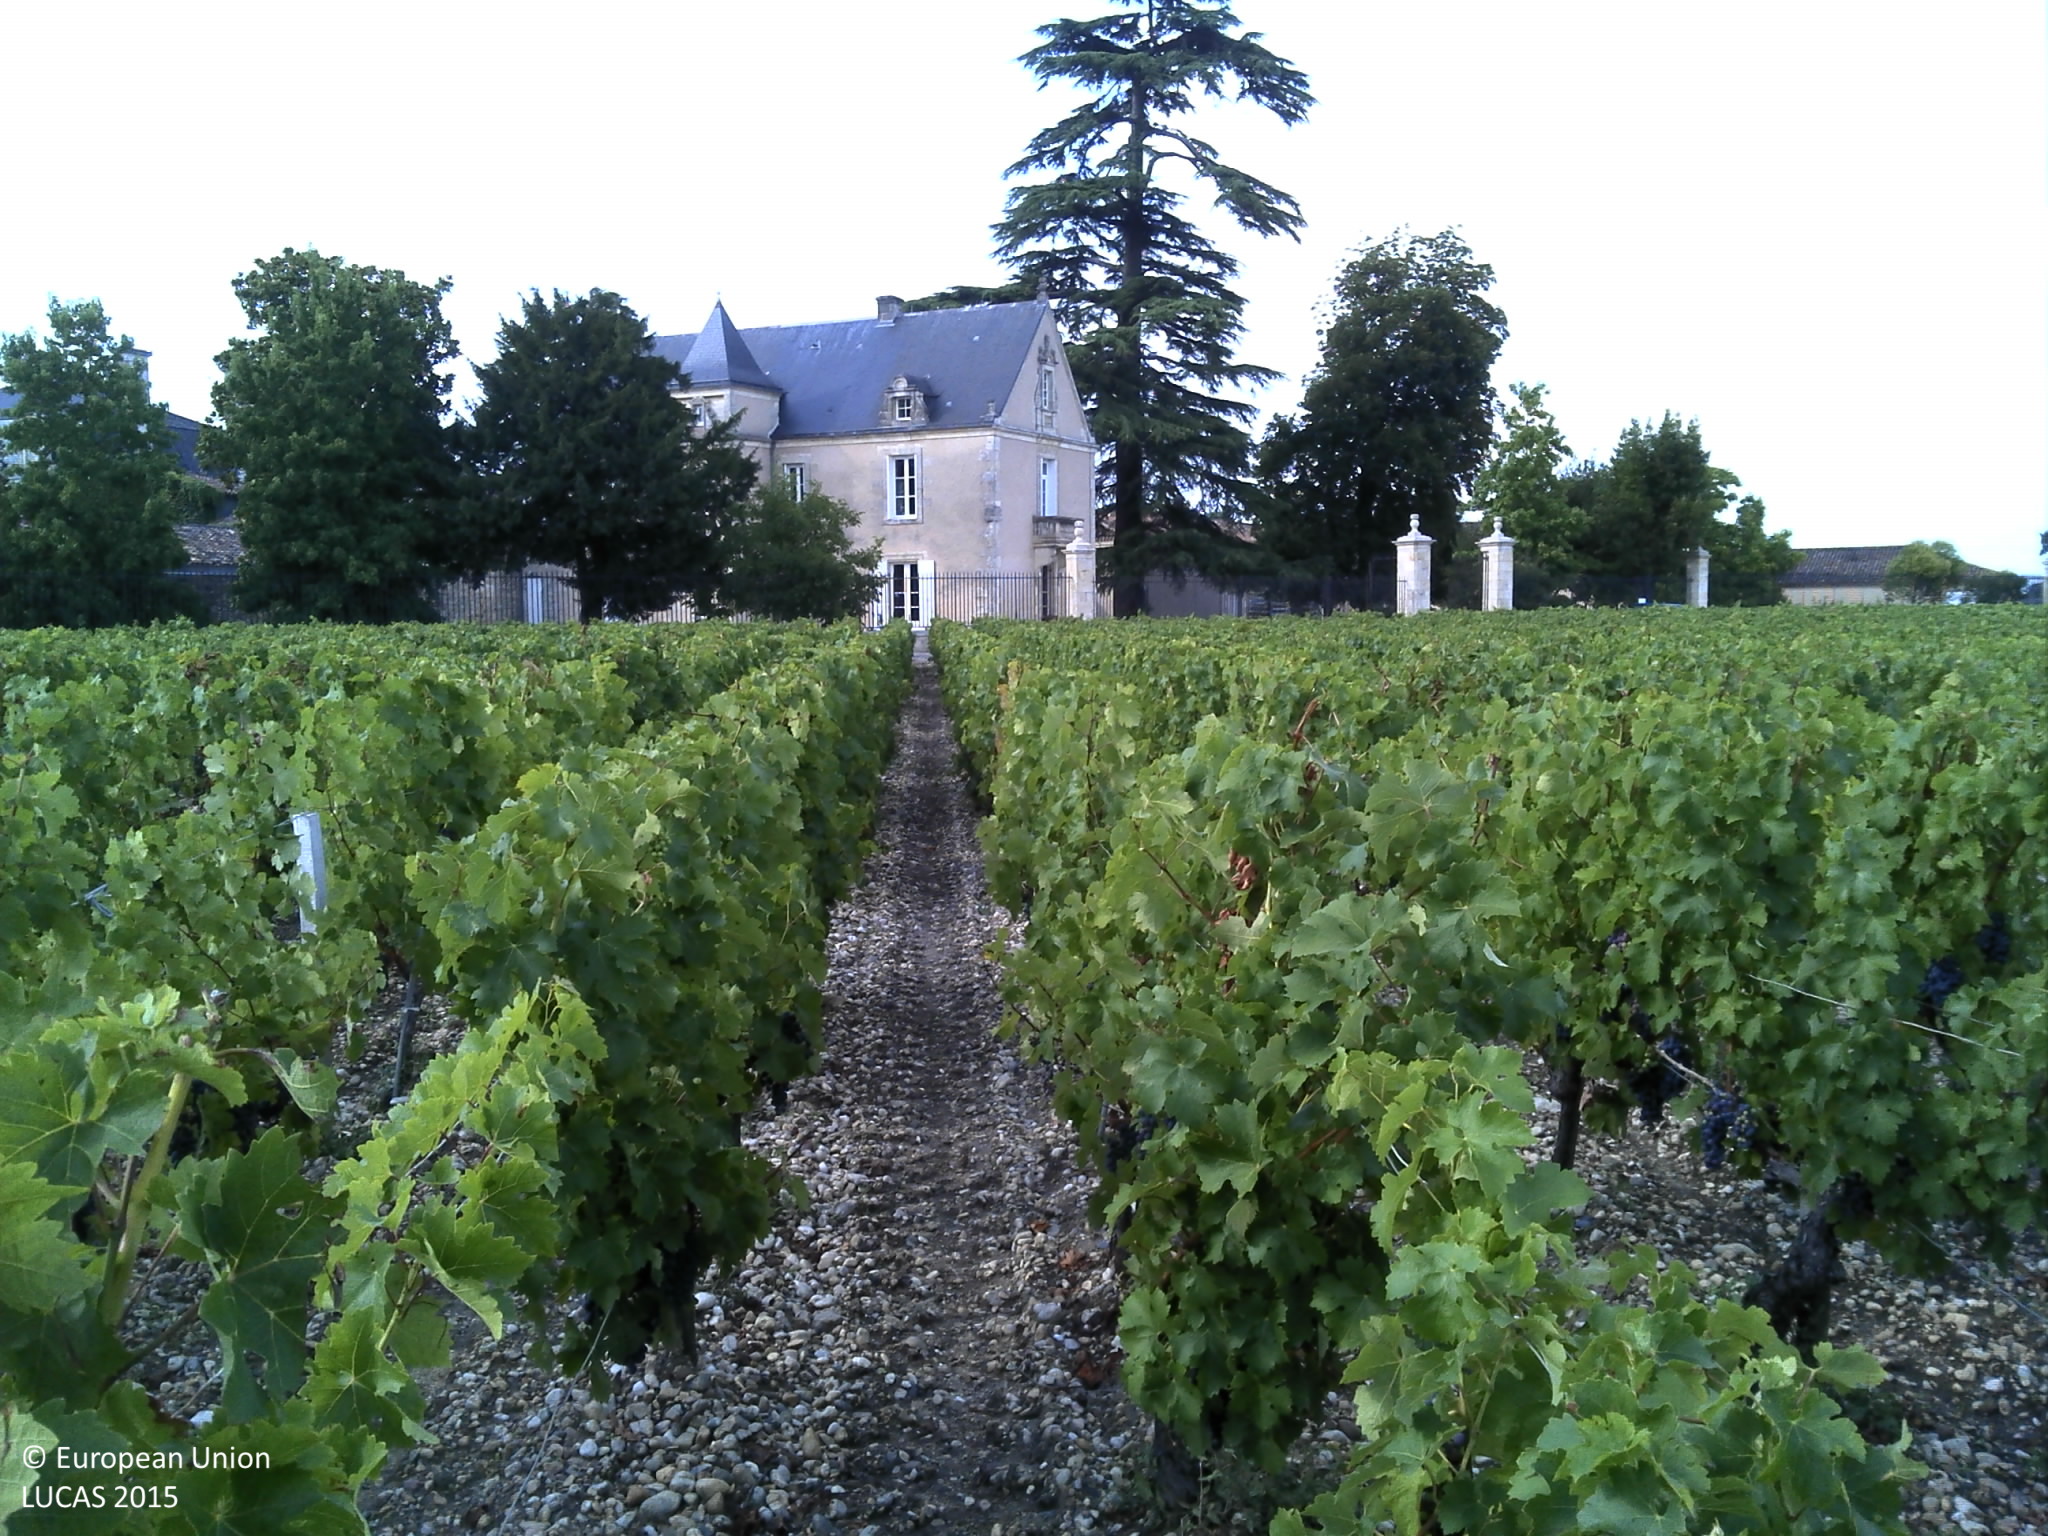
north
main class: Cropland
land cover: Vineyards
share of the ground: 25 - 50 %
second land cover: Other bare soil
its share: > 75 %
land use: Agriculture (excluding fallow land and kitchen gardens)
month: August
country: FR
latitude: 45.2408
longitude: -0.7877
